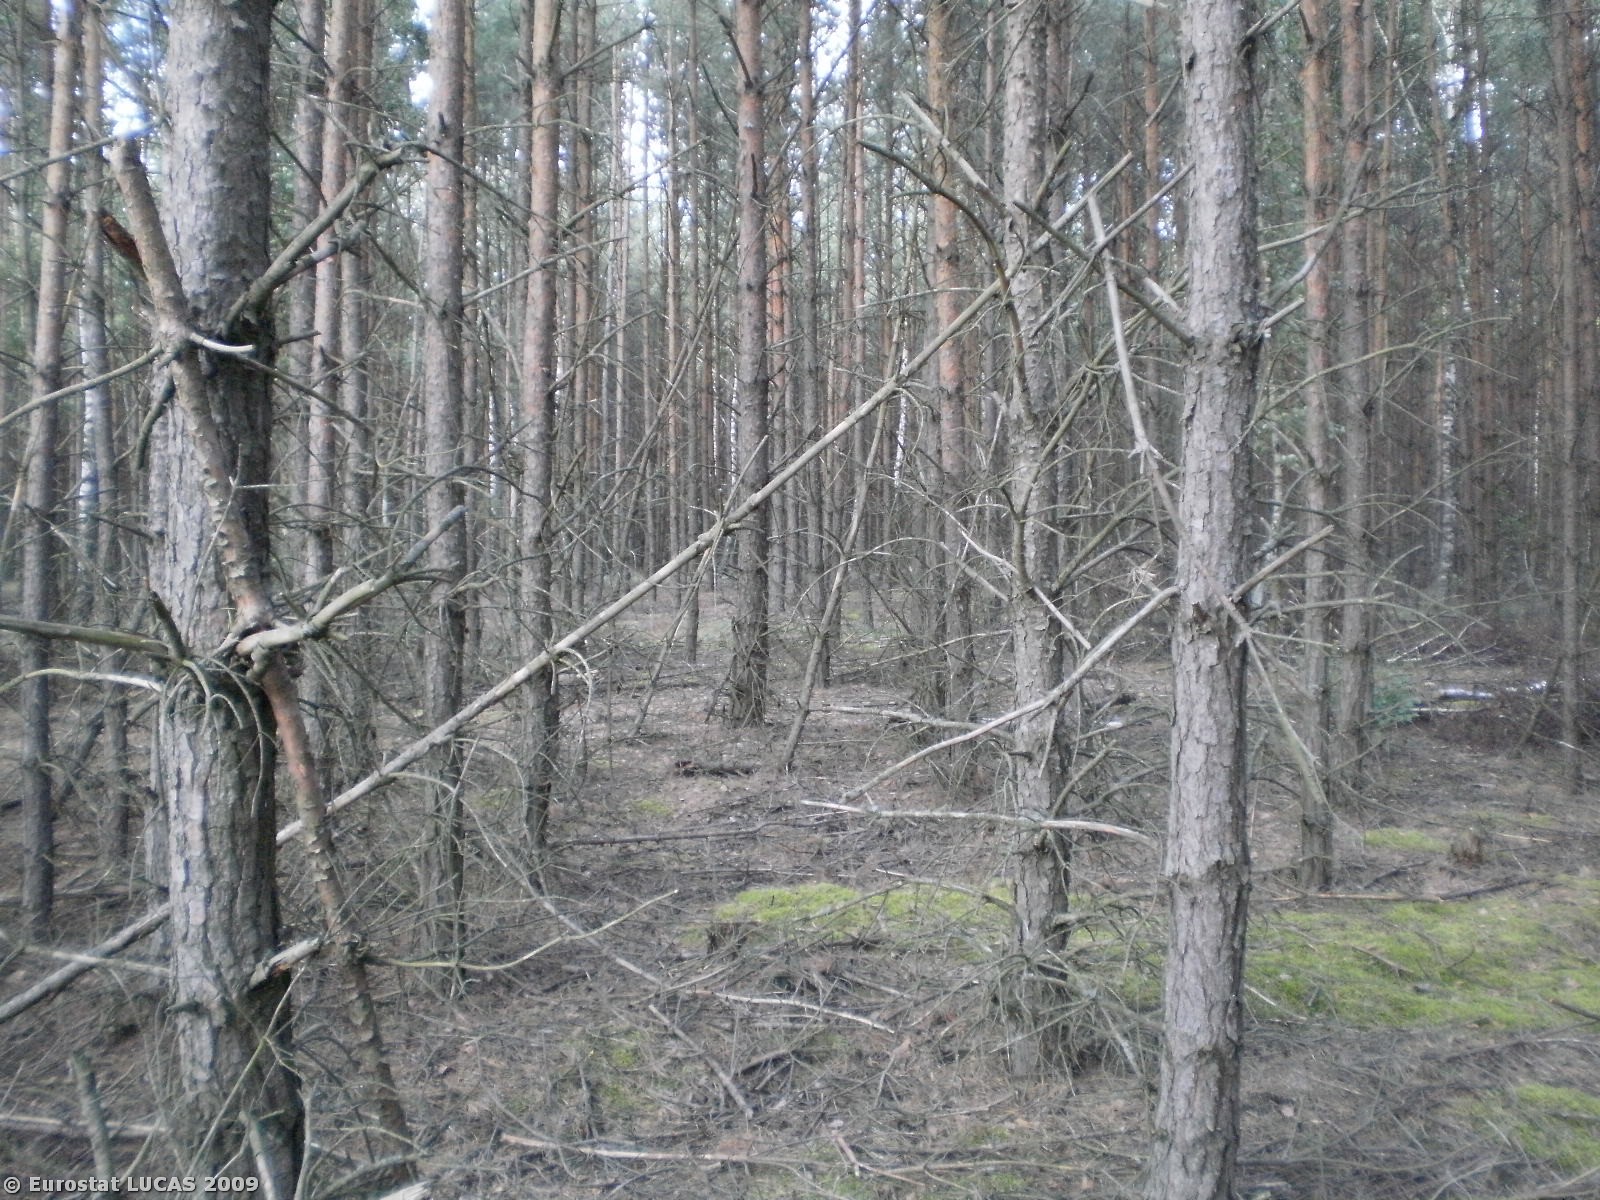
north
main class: Woodland
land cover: Coniferous woodland
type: hemiboreal forest and nemoral coniferous forest and mixed broadleaved-coniferous forest
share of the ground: > 75 %
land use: Forestry
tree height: > 5 m
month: August
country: PL
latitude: 52.8586
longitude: 21.8031
